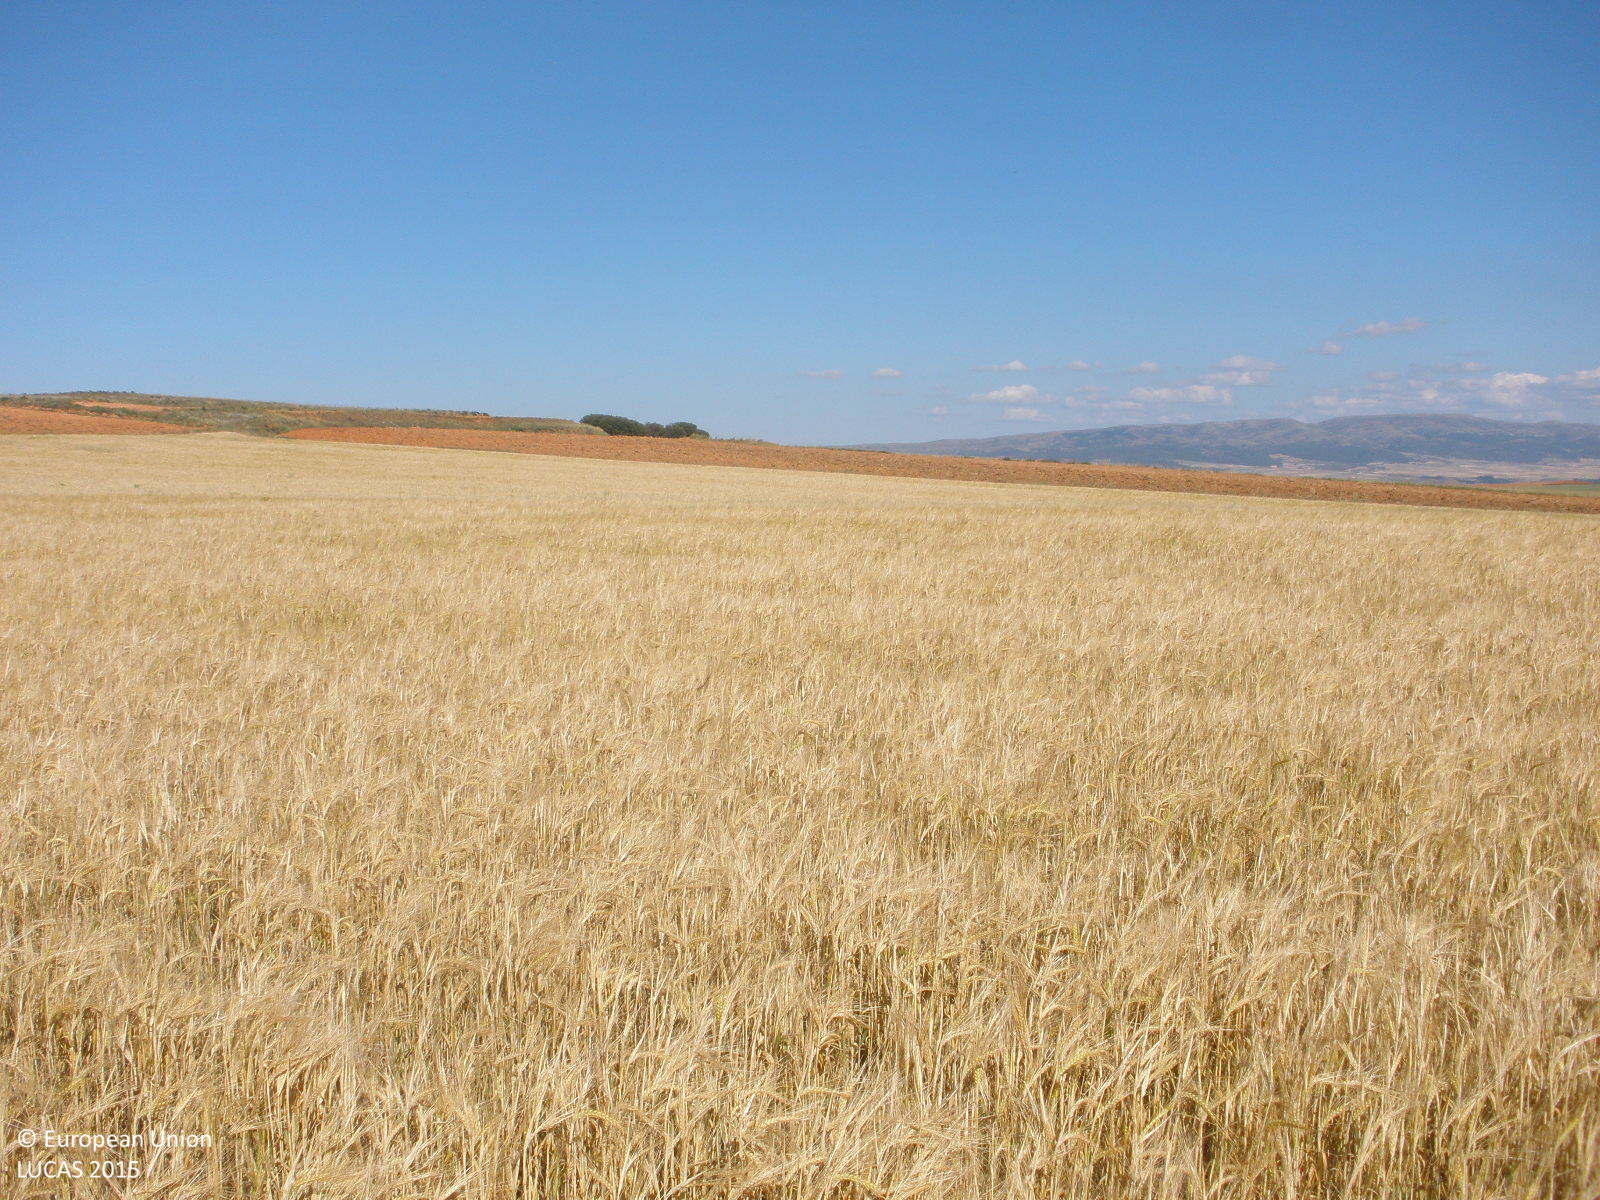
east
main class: Cropland
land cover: Barley
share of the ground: > 75 %
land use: Agriculture (excluding fallow land and kitchen gardens)
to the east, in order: Barley; Grass margins; Other bare soil; Shrubland without tree cover; Other bare soil
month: June
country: ES
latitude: 40.6217
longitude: -1.0898
